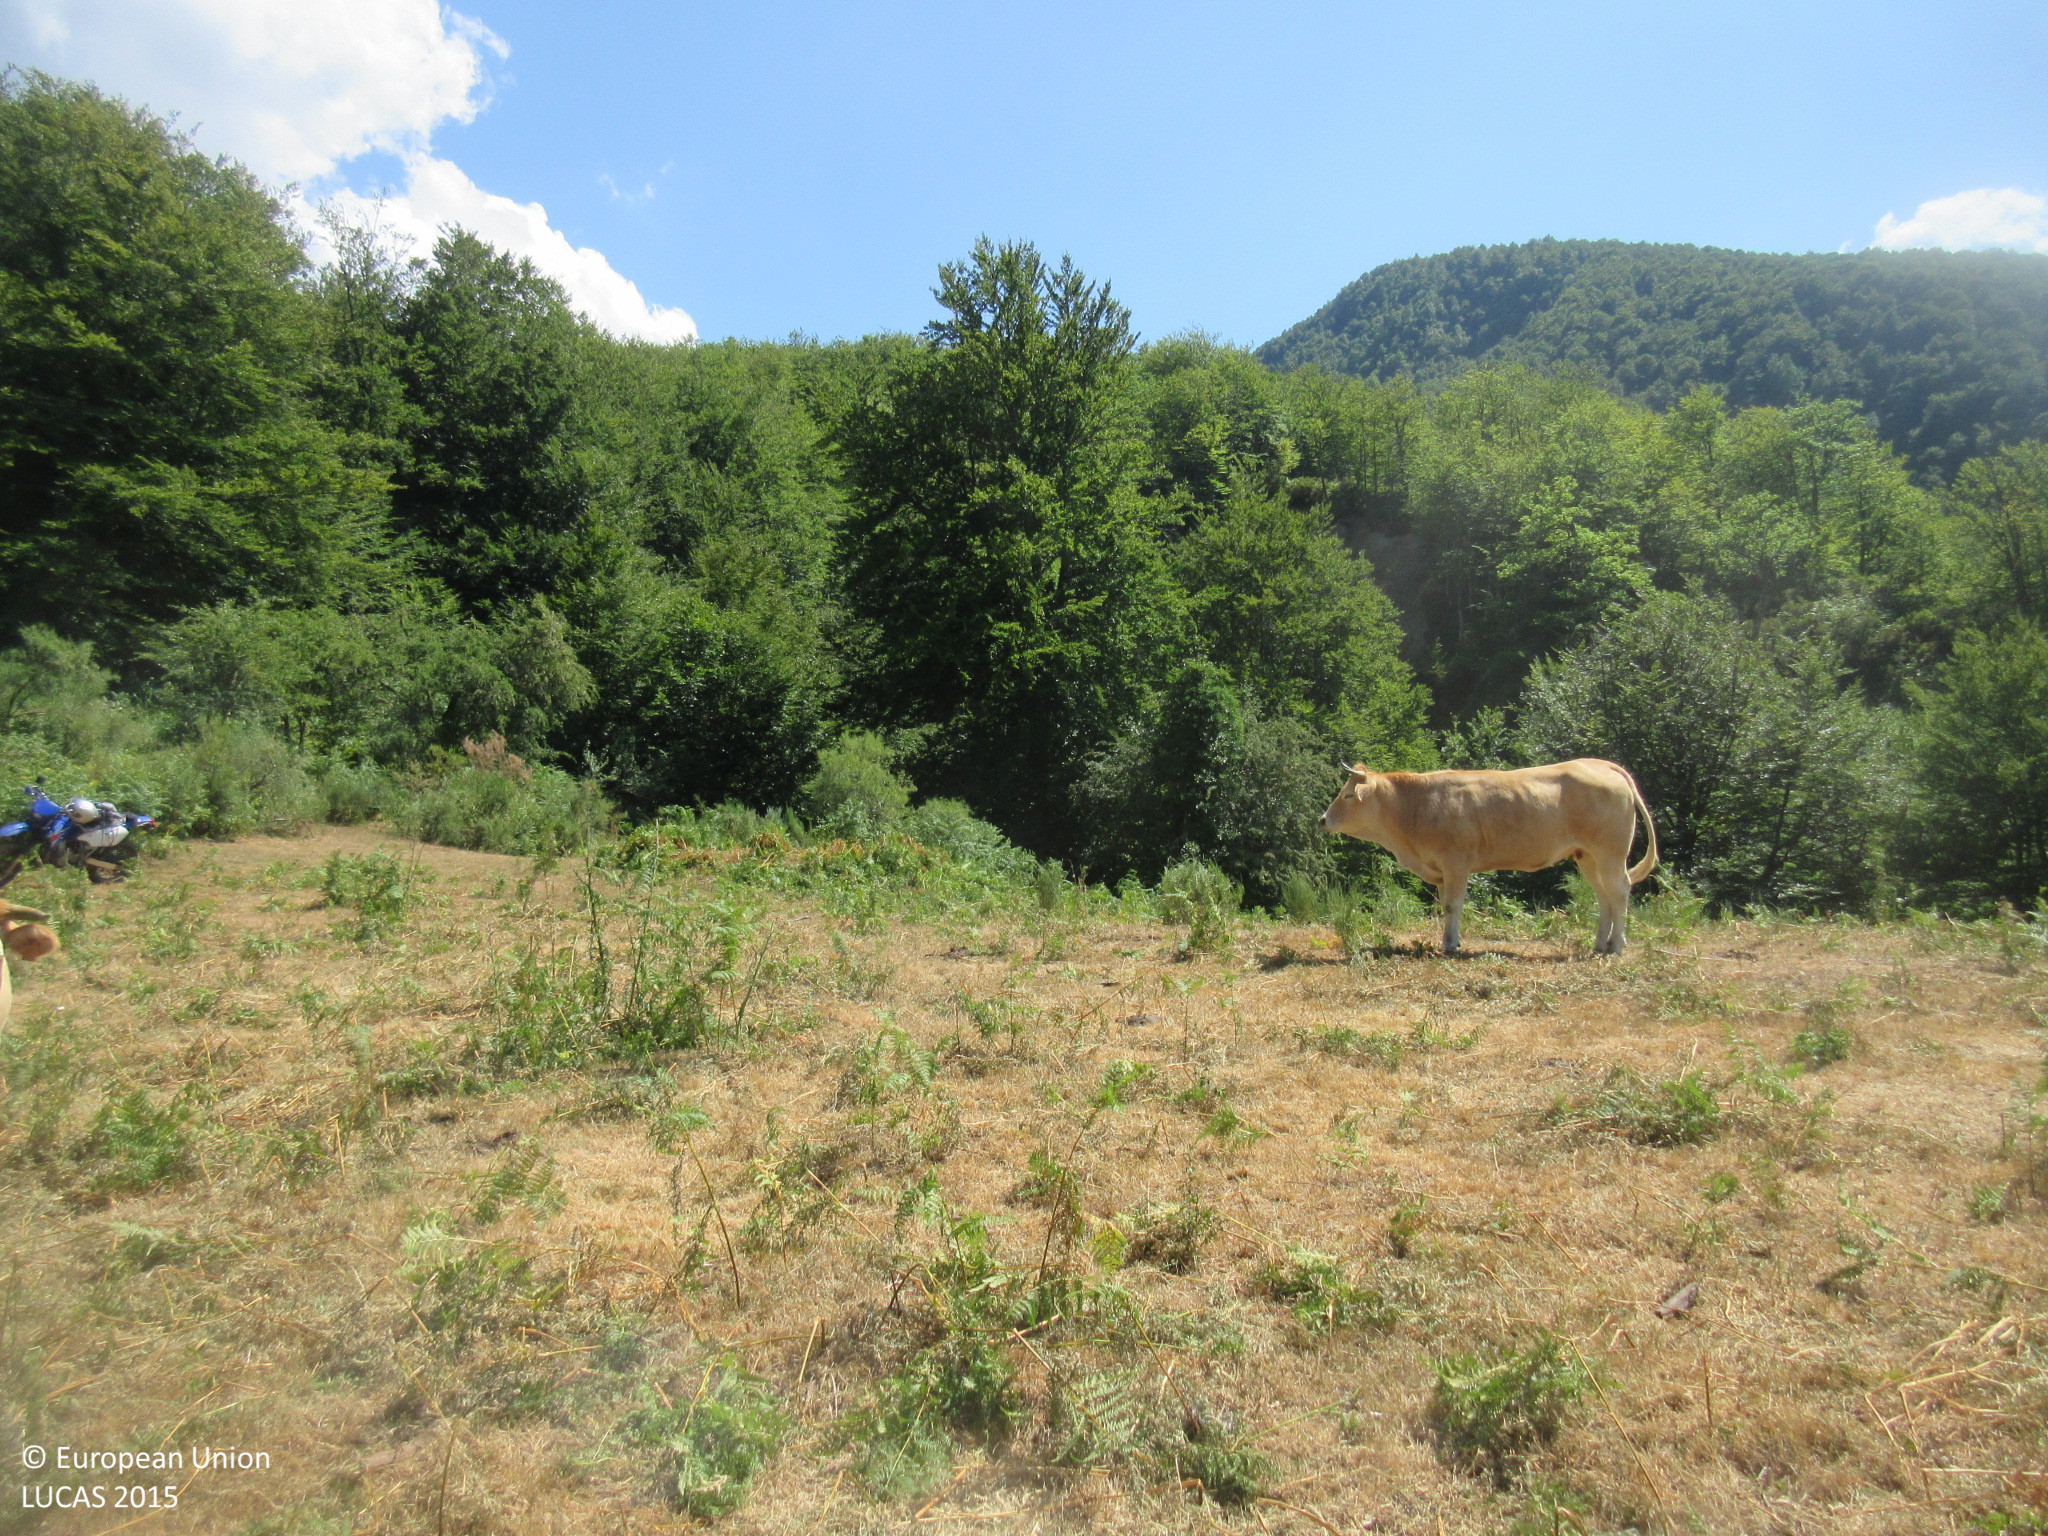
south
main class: Woodland
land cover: Broadleaved woodland
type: mountainous beech forest
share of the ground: > 75 %
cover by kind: broadleaved forest trees 100 %
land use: Forestry
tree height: > 5 m
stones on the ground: < 10 %
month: July
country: ES
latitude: 43.1244
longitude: -5.0015
